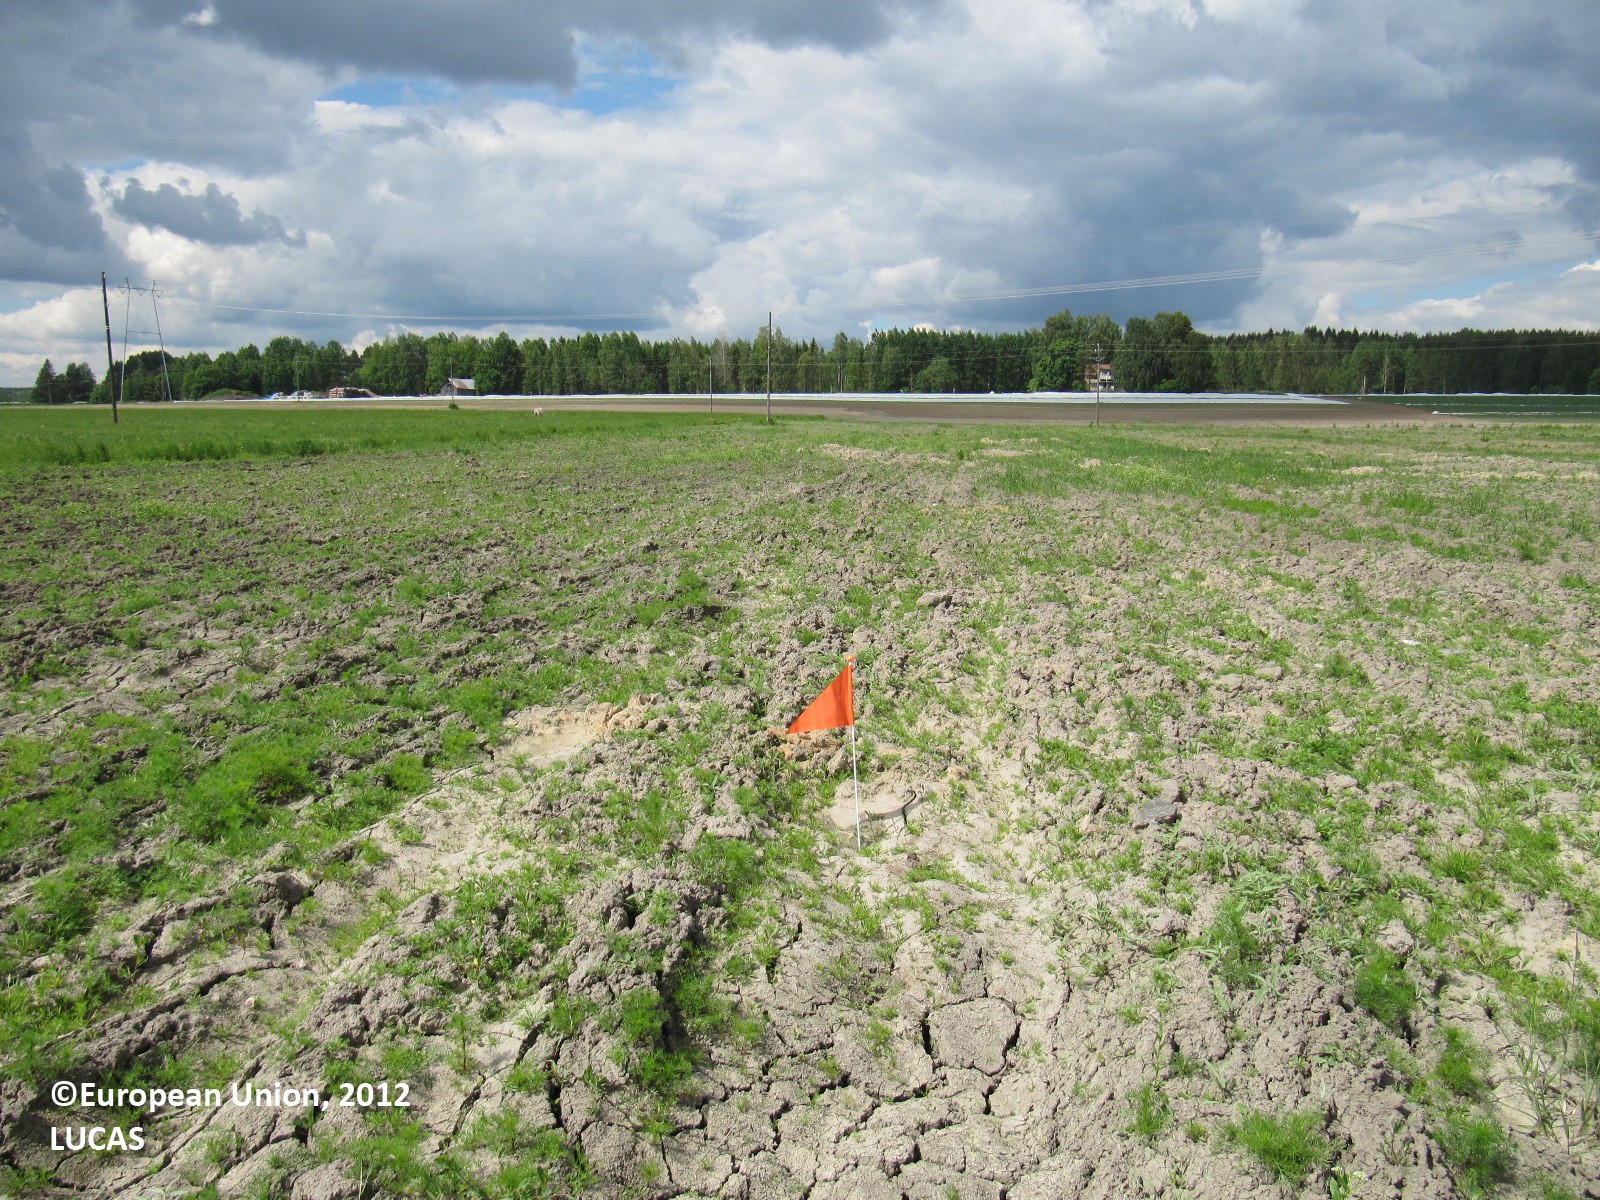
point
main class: Cropland
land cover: Other non-permanent industrial crops
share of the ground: 25 - 50 %
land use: Fallow land
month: June
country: FI
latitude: 60.3567
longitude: 24.3695
